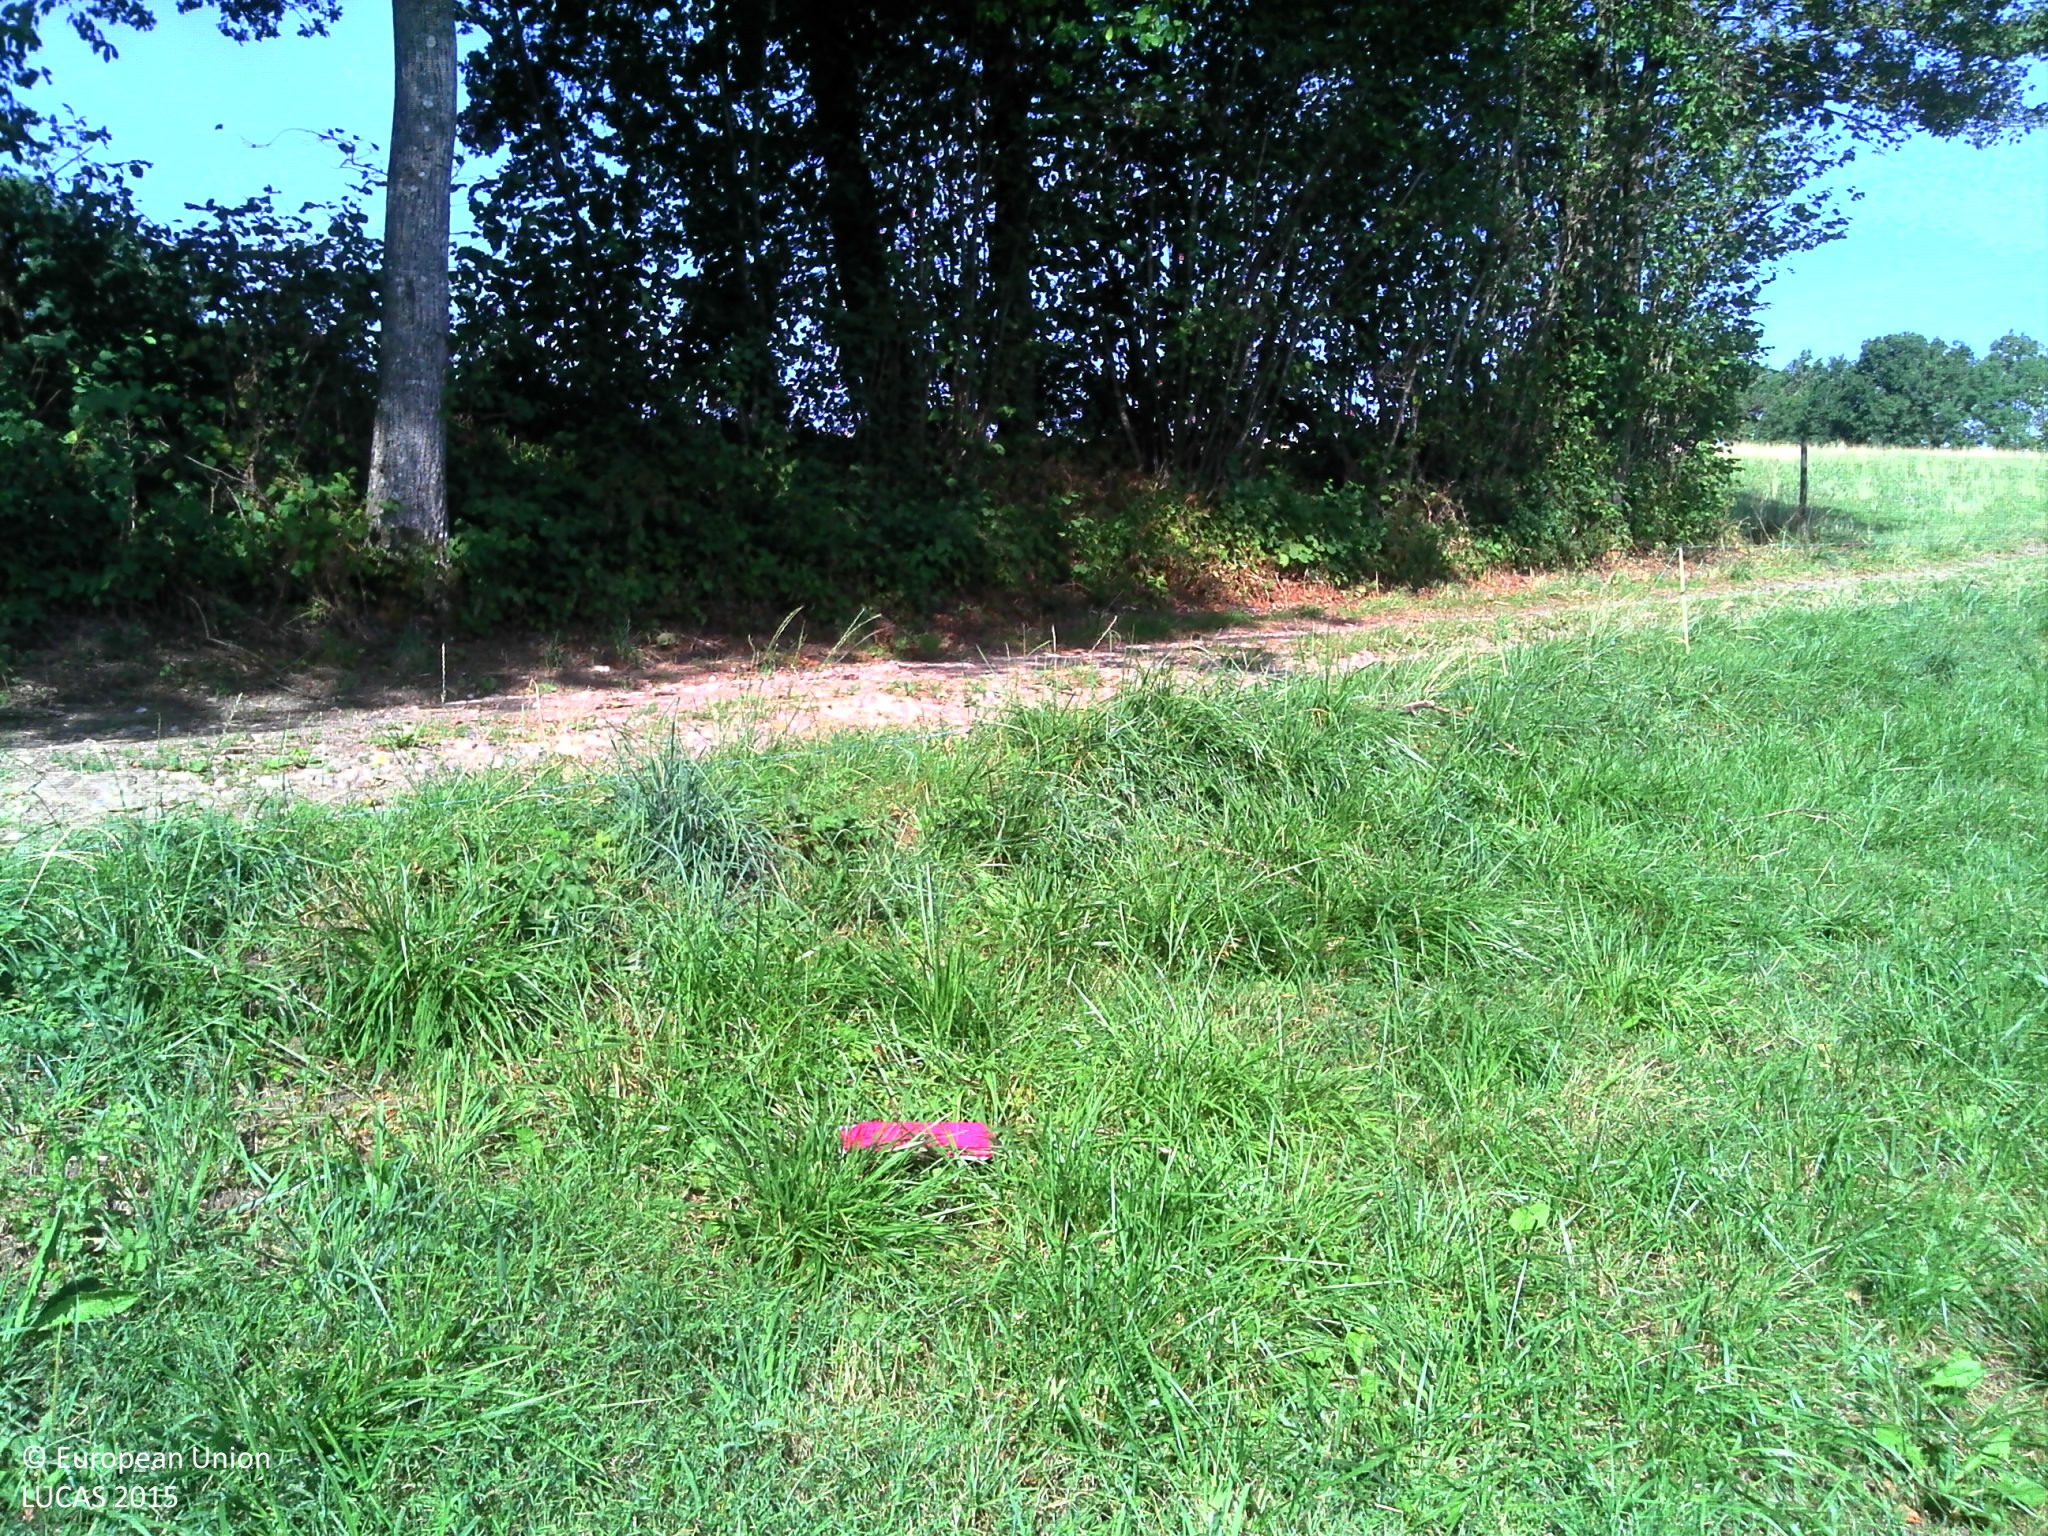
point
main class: Grassland
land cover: Grassland without tree/shrub cover
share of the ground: > 75 %
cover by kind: herbaceous plants 100 %
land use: Agriculture (excluding fallow land and kitchen gardens)
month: July
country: FR
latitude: 46.1452
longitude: 6.3656
